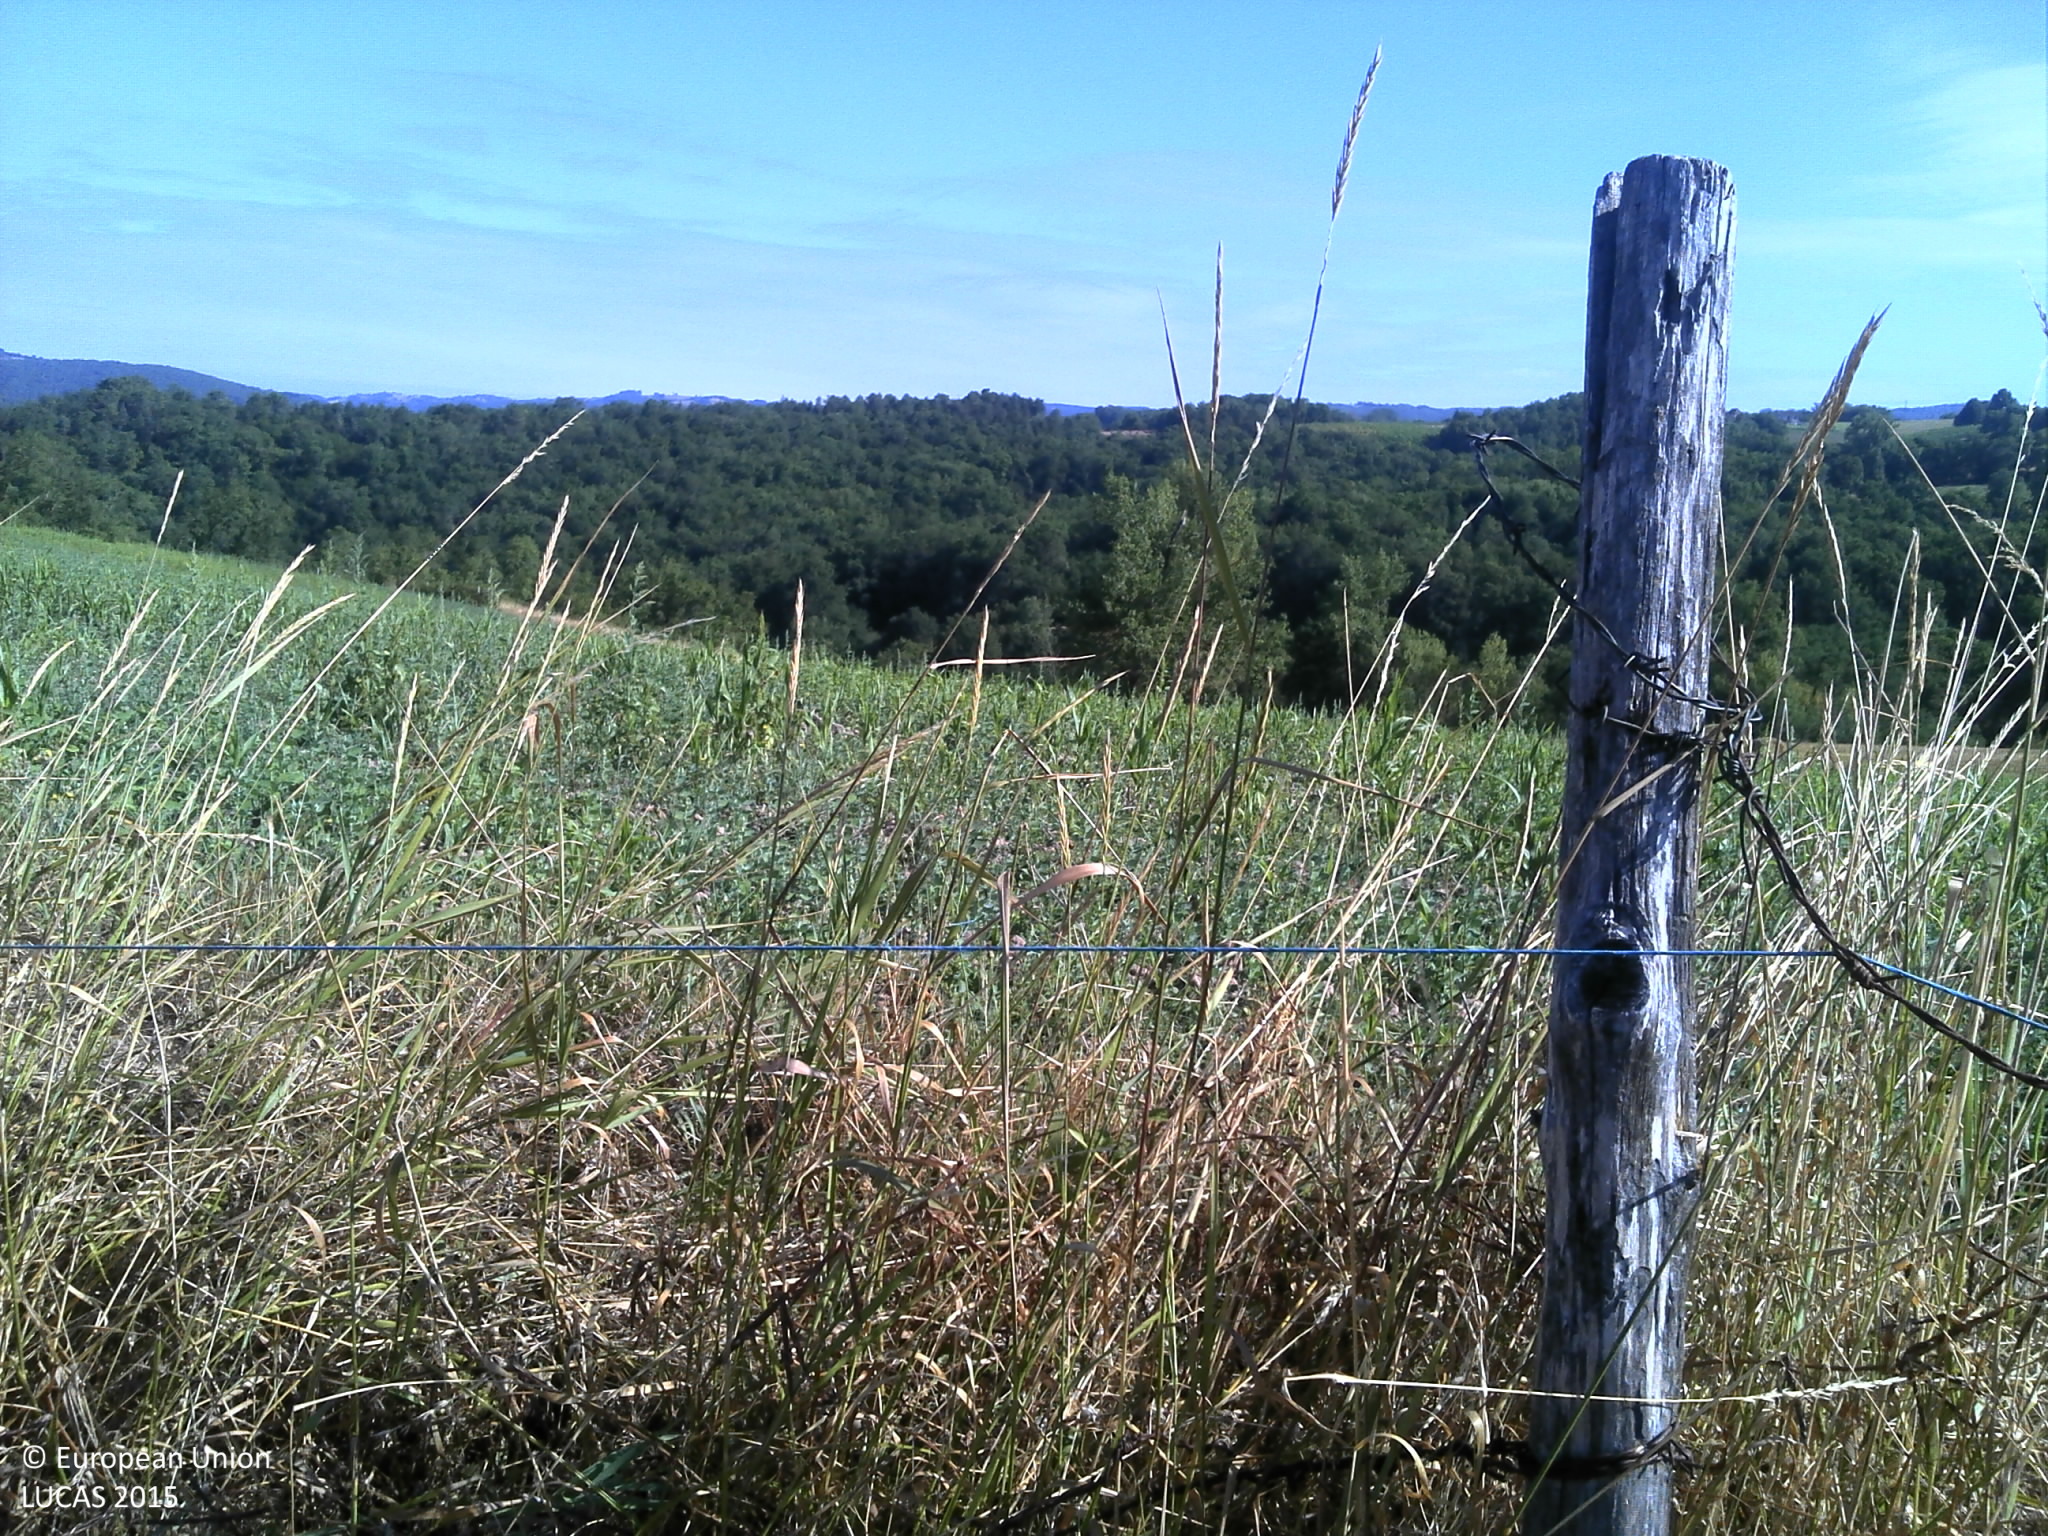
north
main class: Cropland
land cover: Mixed cereals for fodder
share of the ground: > 75 %
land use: Agriculture (excluding fallow land and kitchen gardens)
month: July
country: FR
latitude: 45.0190
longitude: 1.7613
